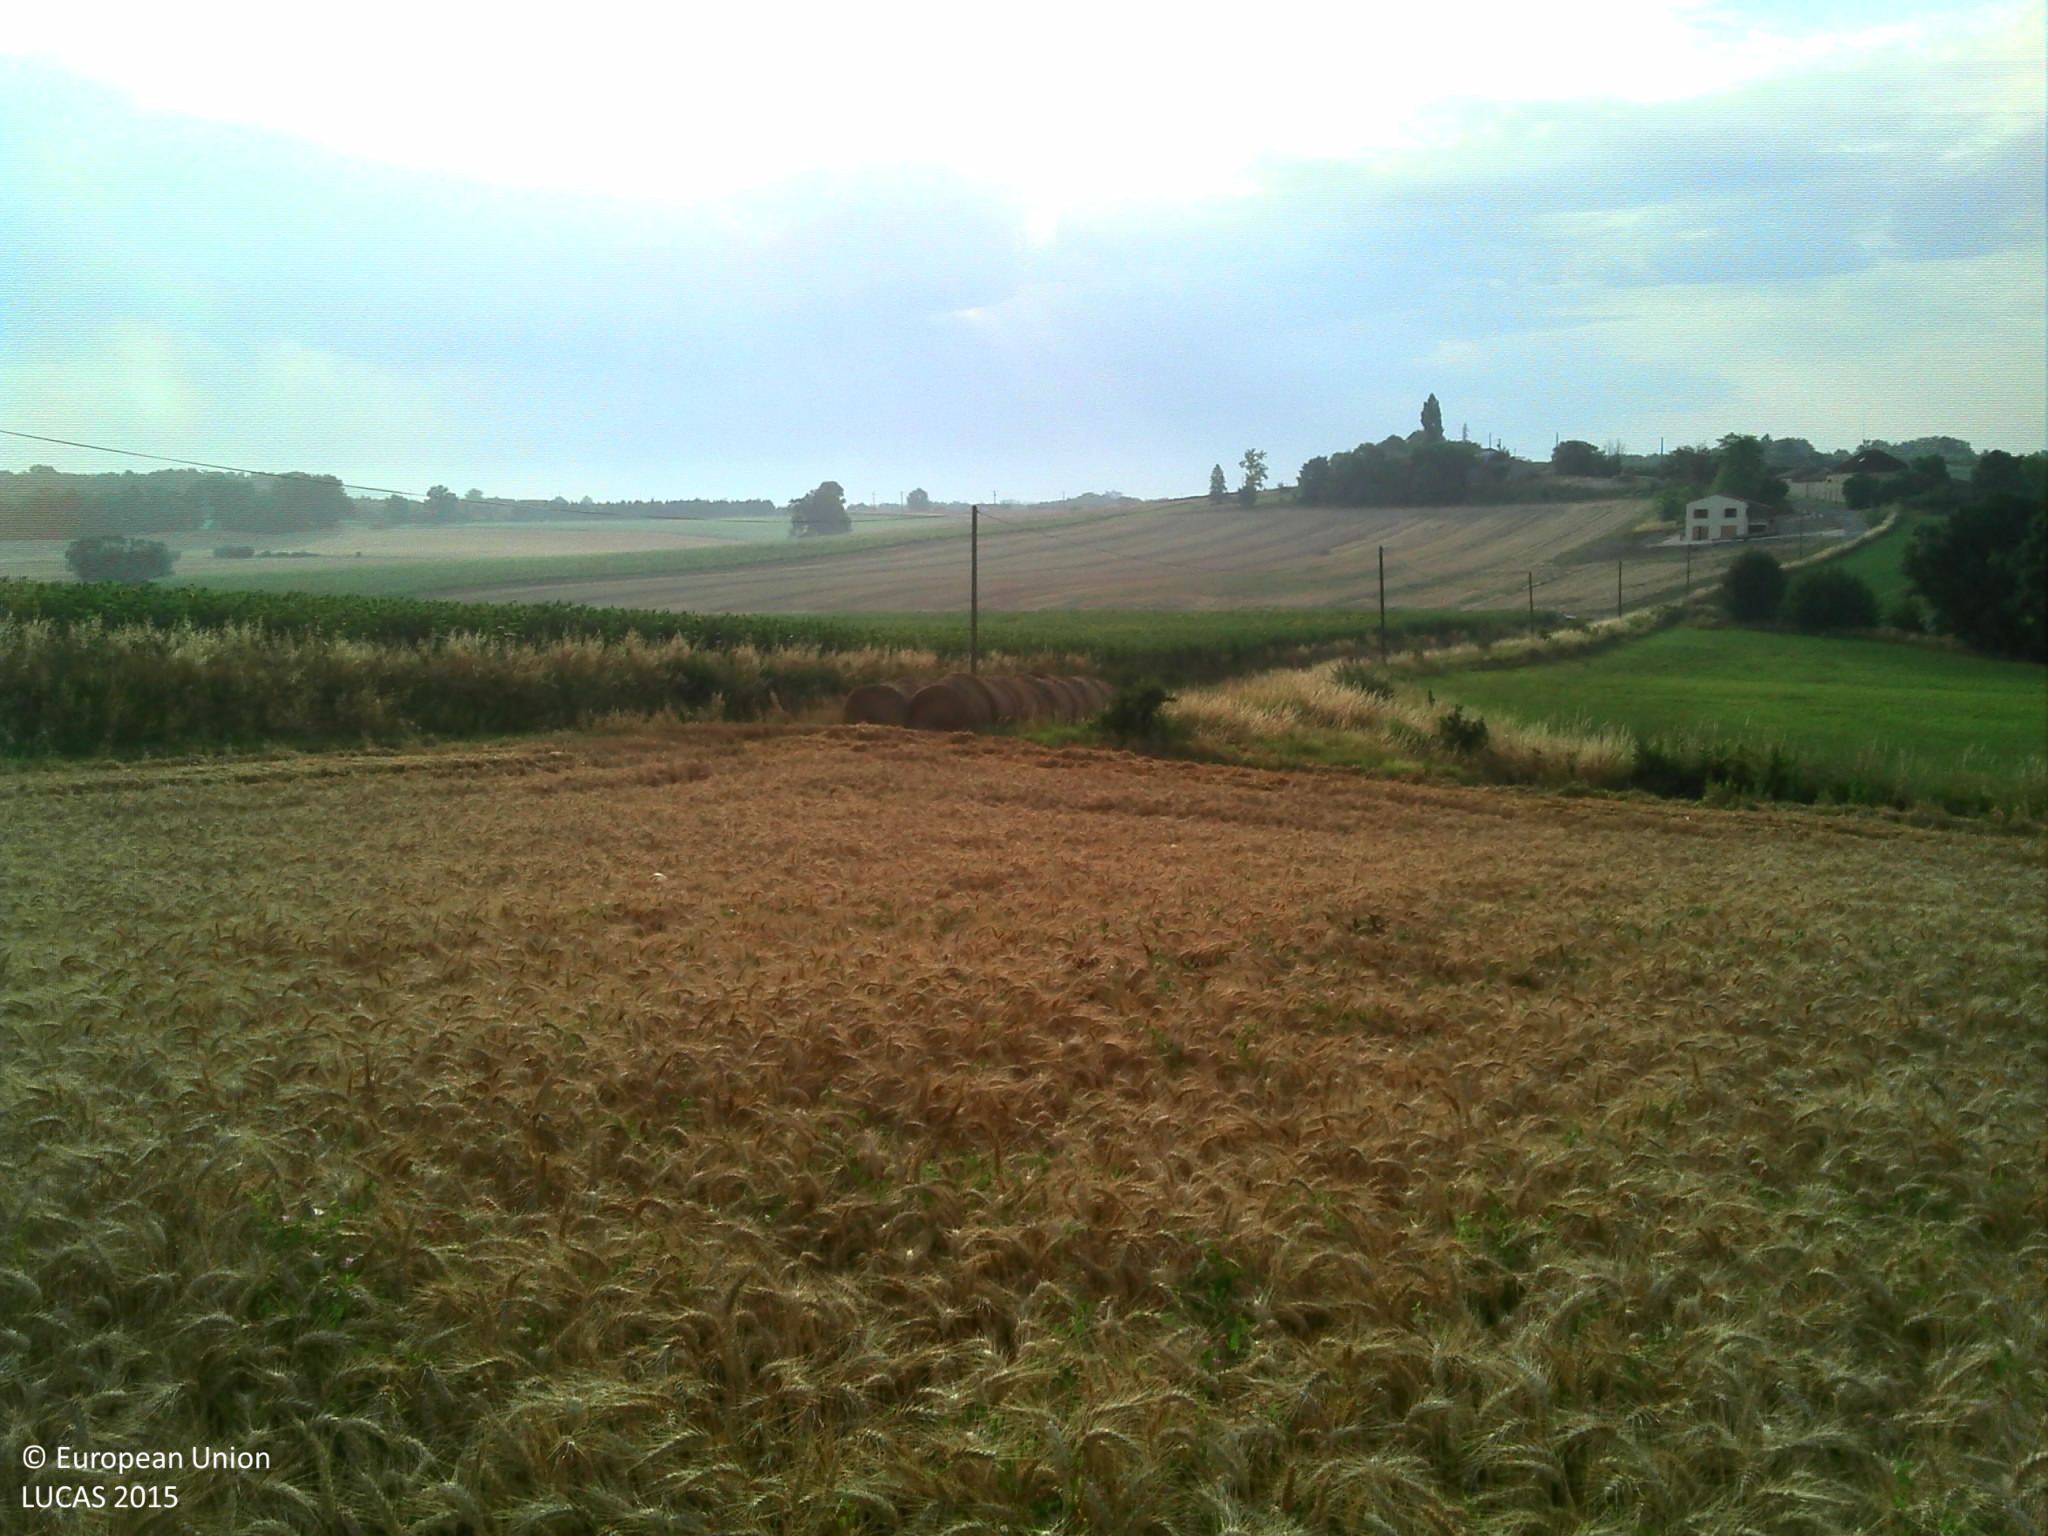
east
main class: Cropland
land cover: Common wheat
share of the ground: > 75 %
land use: Agriculture (excluding fallow land and kitchen gardens)
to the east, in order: Common wheat; Spontaneously vegetated surfaces; Electric lines; Paved roads, cycling and walking lanes; Ditches and canals; Sunflower; Tracks; Ditches and canals; Rape and turnip rape
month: July
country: FR
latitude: 44.5035
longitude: 0.7999
